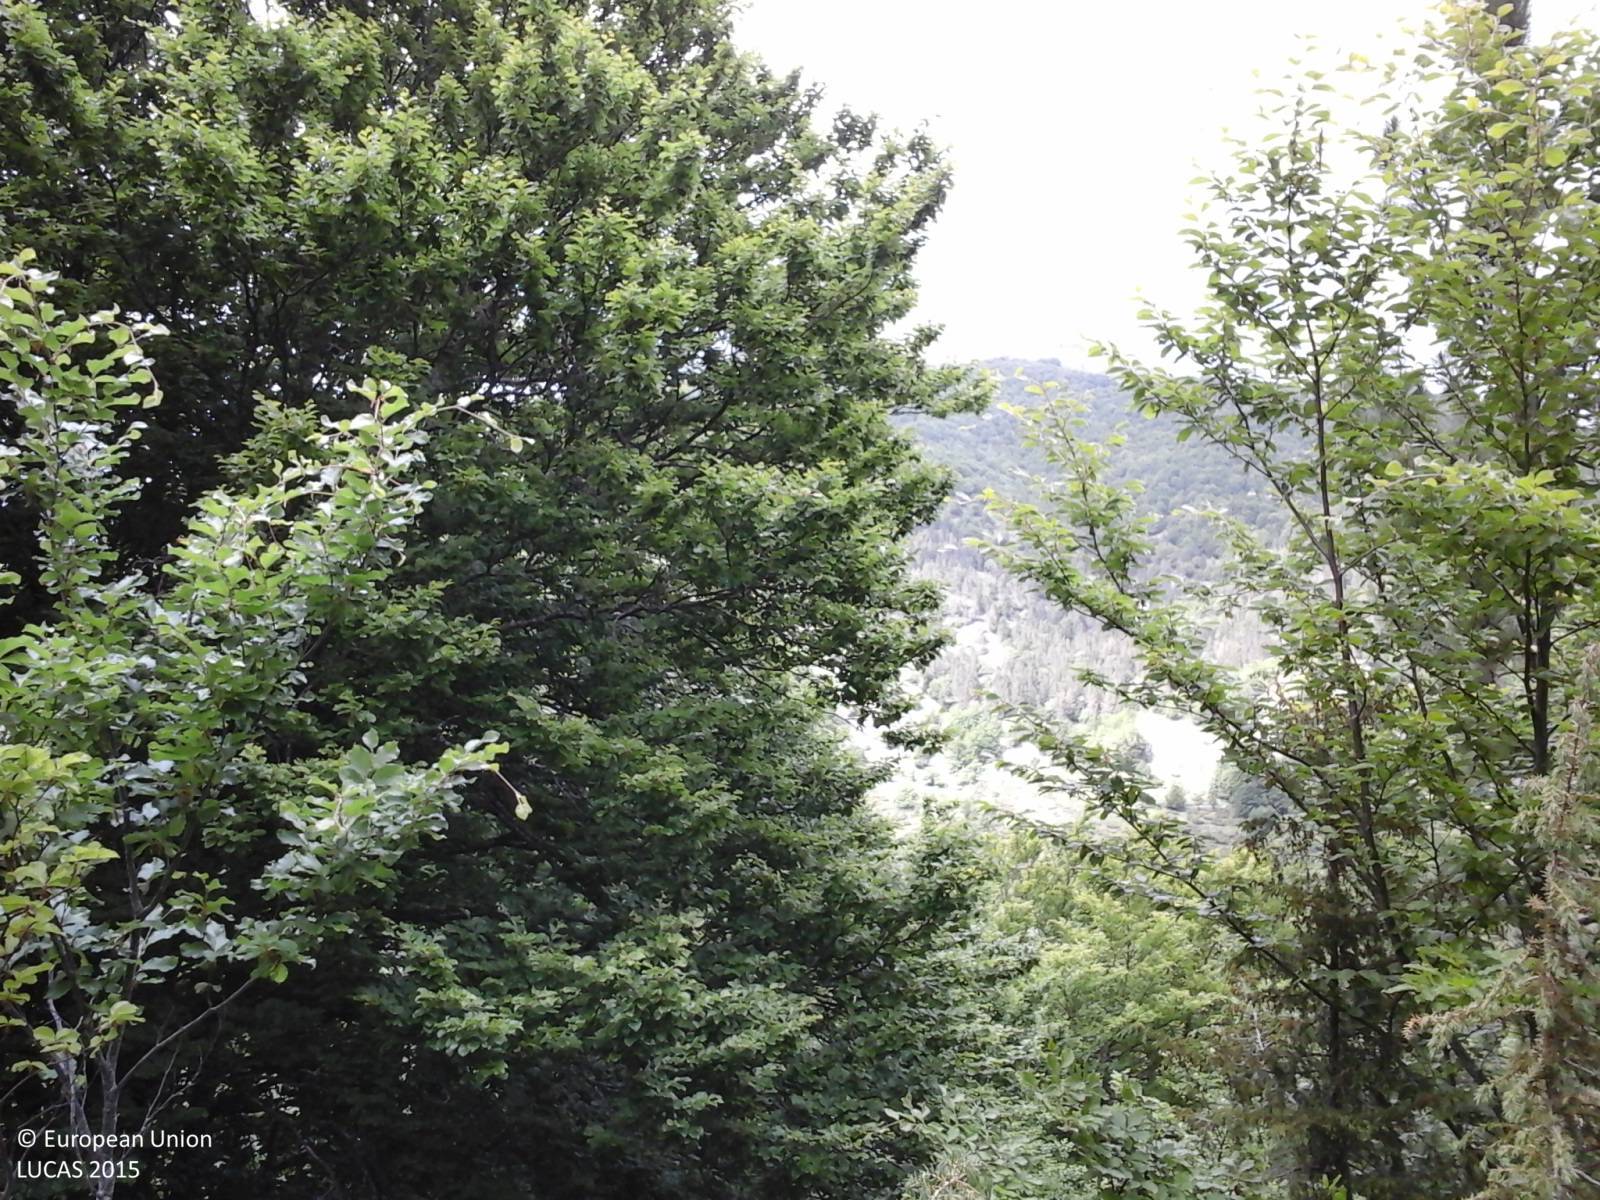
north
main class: Woodland
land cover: Broadleaved woodland
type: mountainous beech forest
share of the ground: 25 - 50 %
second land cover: Grassland without tree/shrub cover
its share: > 75 %
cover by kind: broadleaved forest trees 70 %, shrubs 20 %, herbaceous plants 10 %
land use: Forestry
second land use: Agriculture (excluding fallow land and kitchen gardens)
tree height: > 5 m
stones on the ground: < 10 %
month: May
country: IT
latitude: 41.8231
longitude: 13.8031
